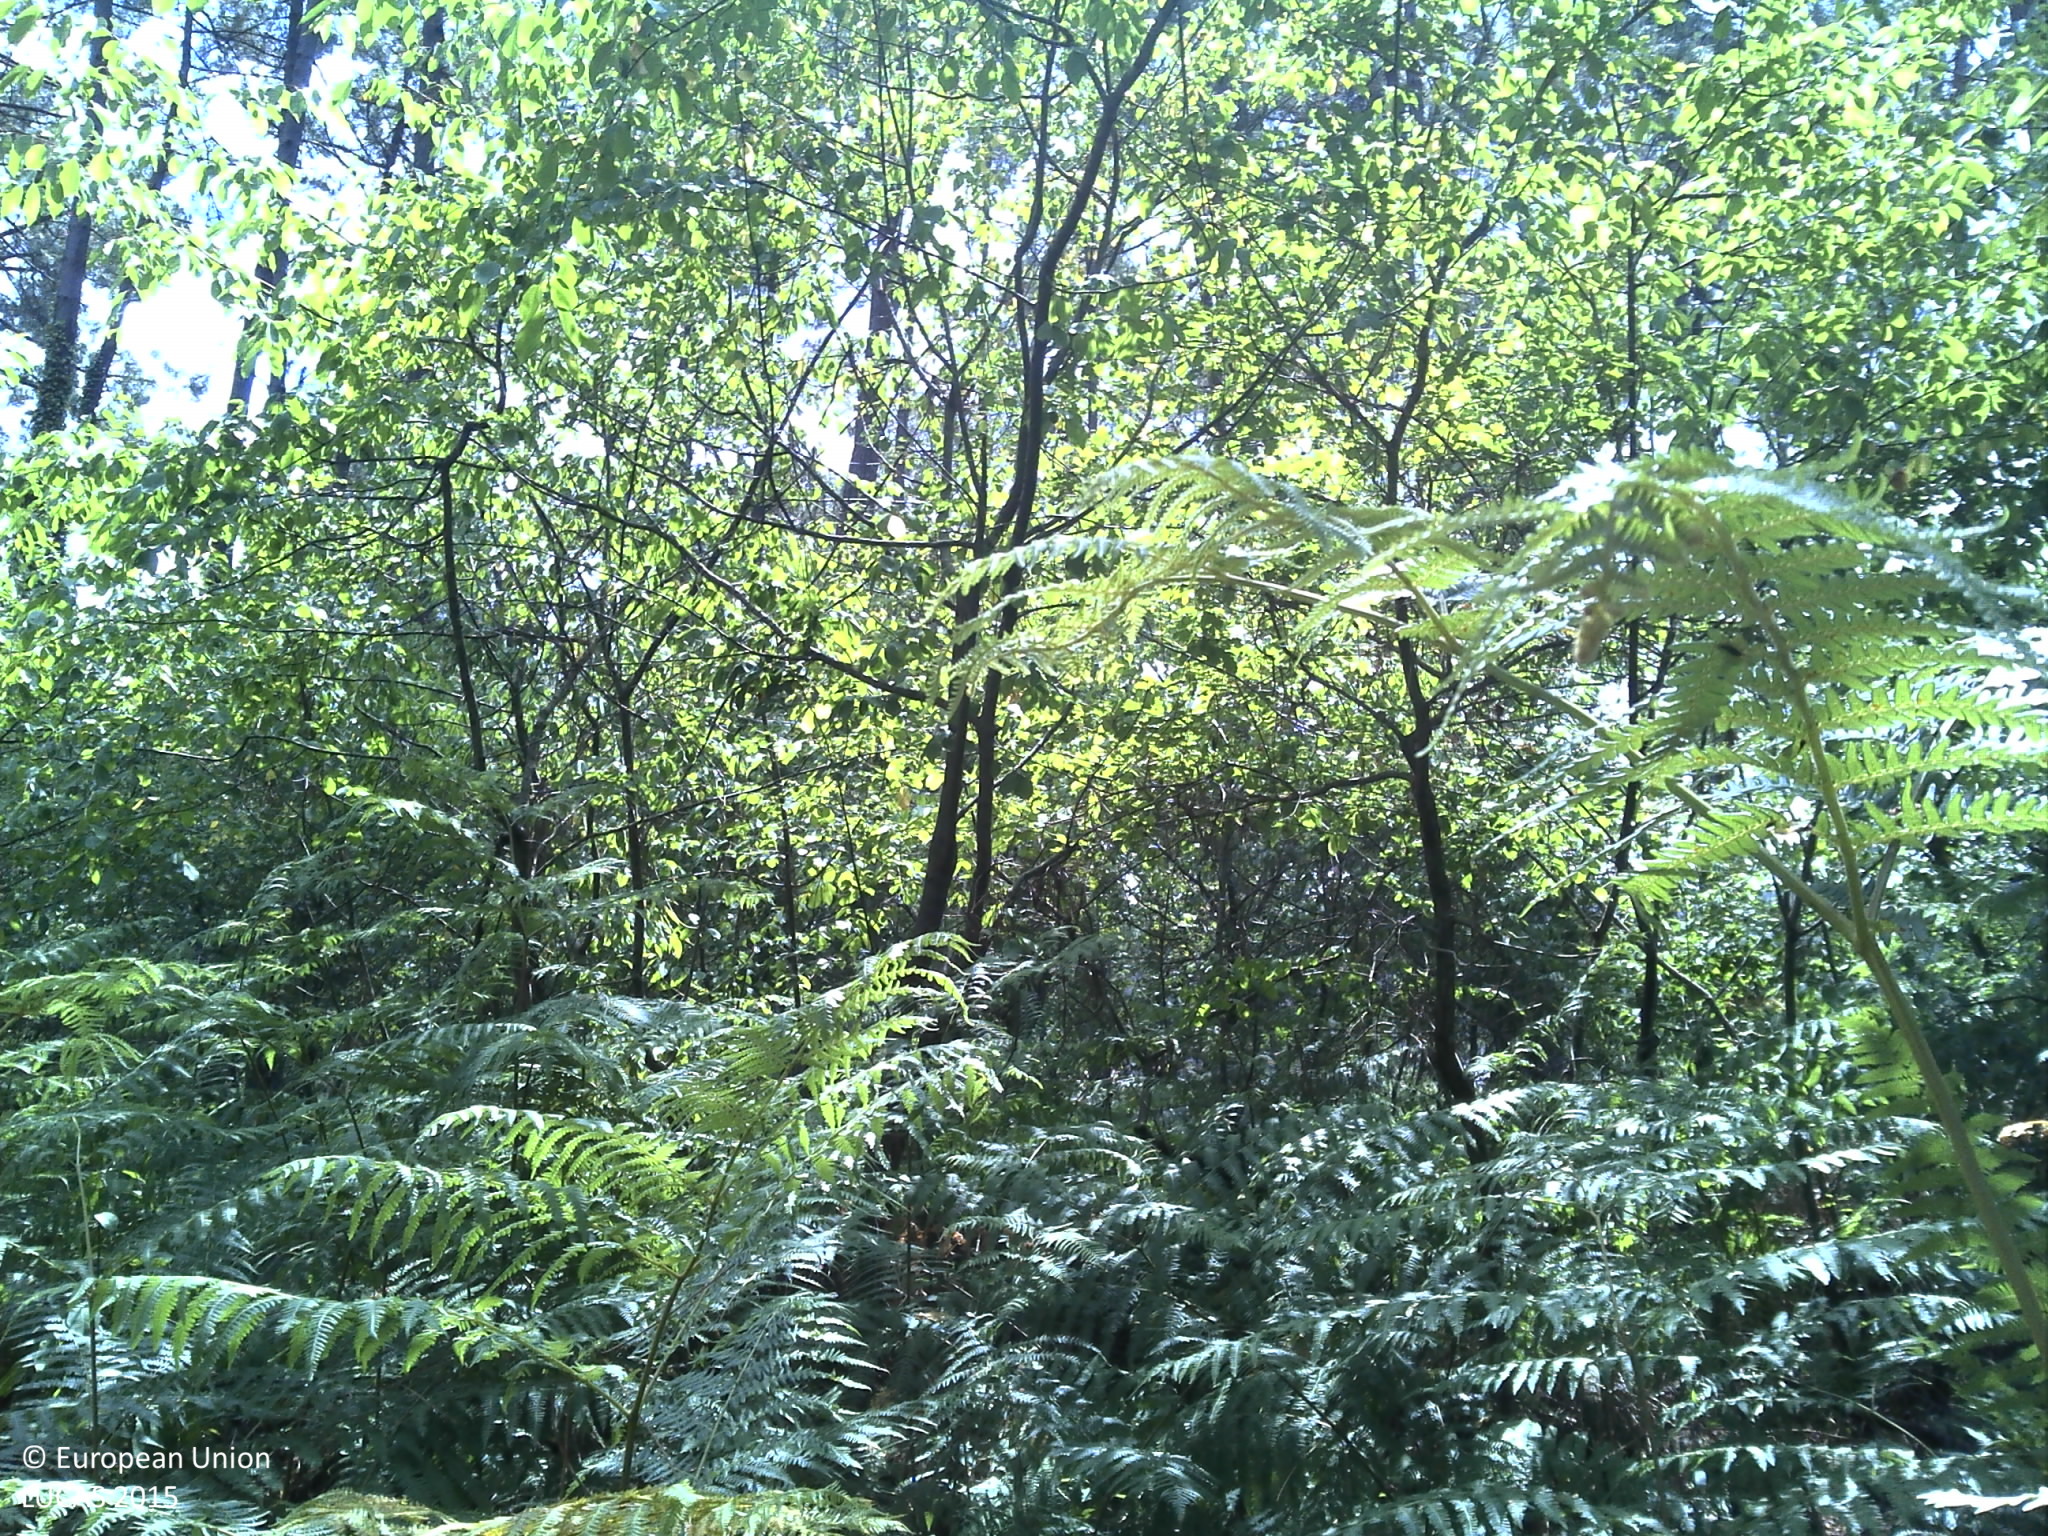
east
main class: Woodland
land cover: Pine dominated coniferous woodland
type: coniferous forest of the mediterranean region
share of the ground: > 75 %
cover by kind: coniferous forest trees 60 %, herbaceous plants 20 %, broadleaved forest trees 10 %, shrubs 10 %
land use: Forestry
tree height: > 5 m
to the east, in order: Pine dominated coniferous woodland; Broadleaved woodland; Ditches and canals; Artificial constructions in urban areas
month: July
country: FR
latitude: 44.8514
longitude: -0.6863
